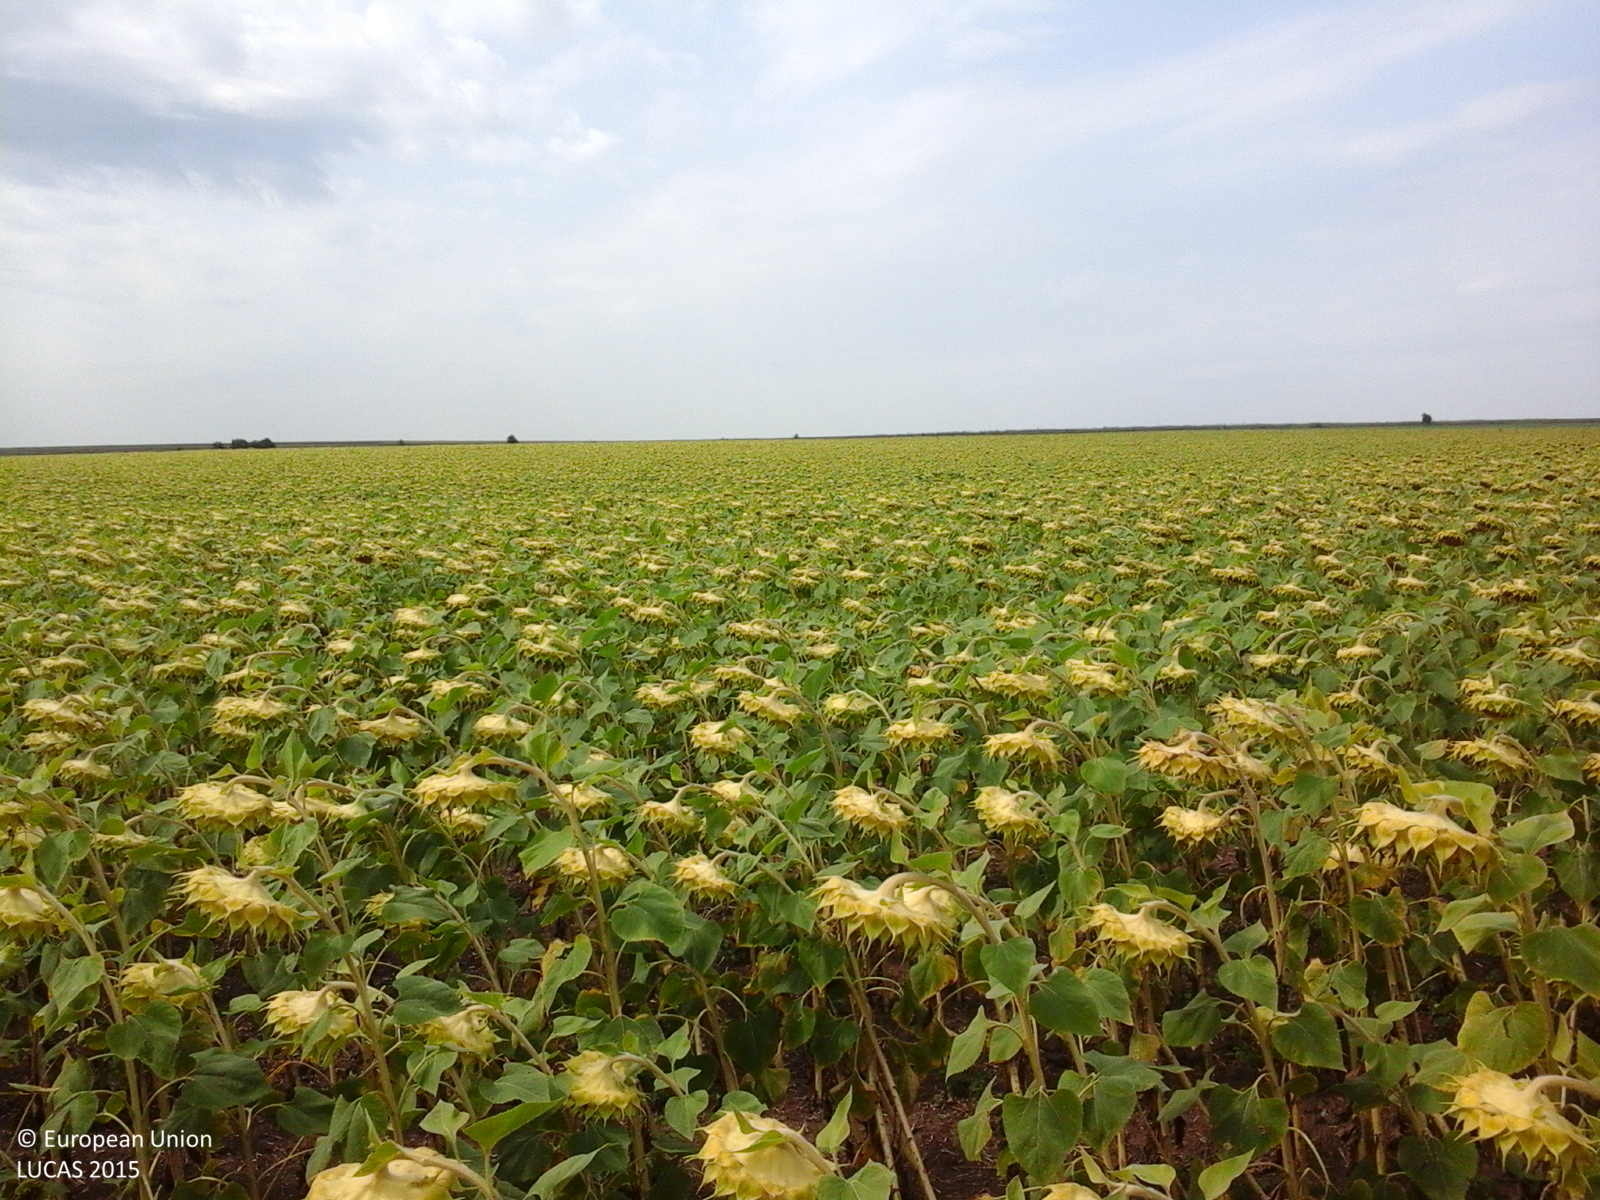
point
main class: Cropland
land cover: Sunflower
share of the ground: > 75 %
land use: Agriculture (excluding fallow land and kitchen gardens)
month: August
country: RO
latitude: 43.8358
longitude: 28.0732
